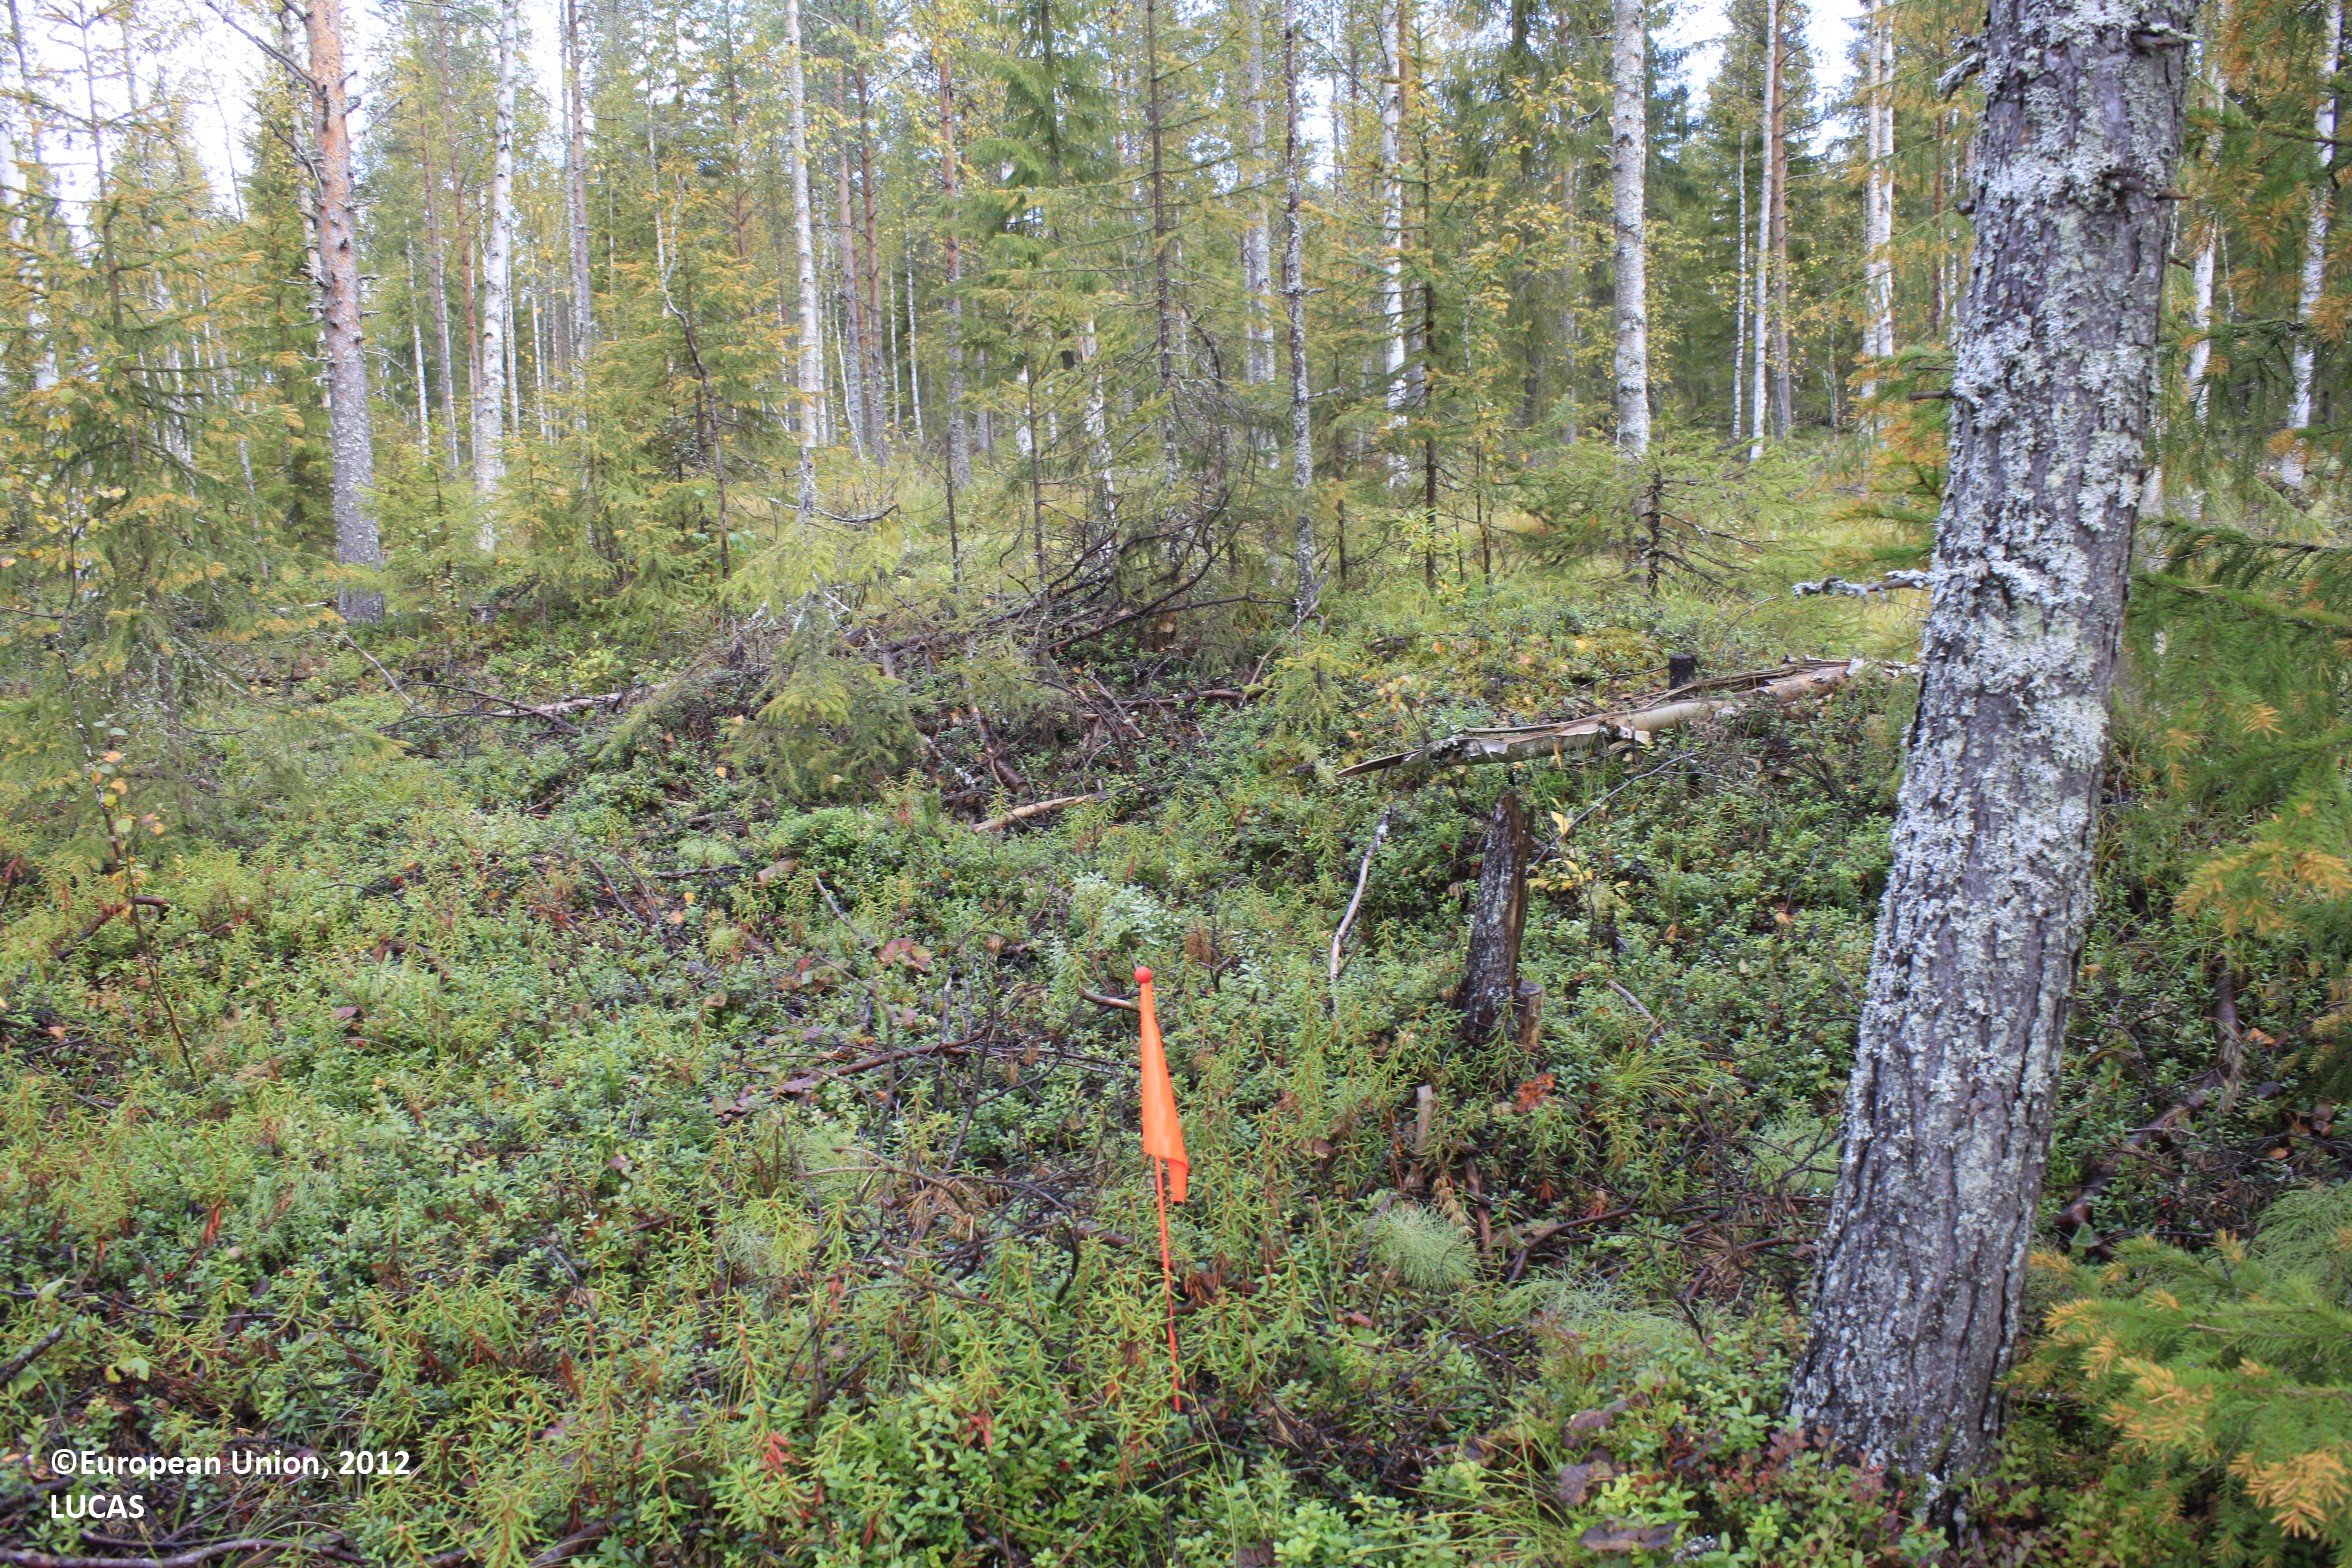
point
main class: Woodland
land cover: Pine dominated mixed woodland
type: boreal forest
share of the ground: 25 - 50 %
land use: Forestry
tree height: > 5 m
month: September
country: FI
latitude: 65.5406
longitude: 26.5744
